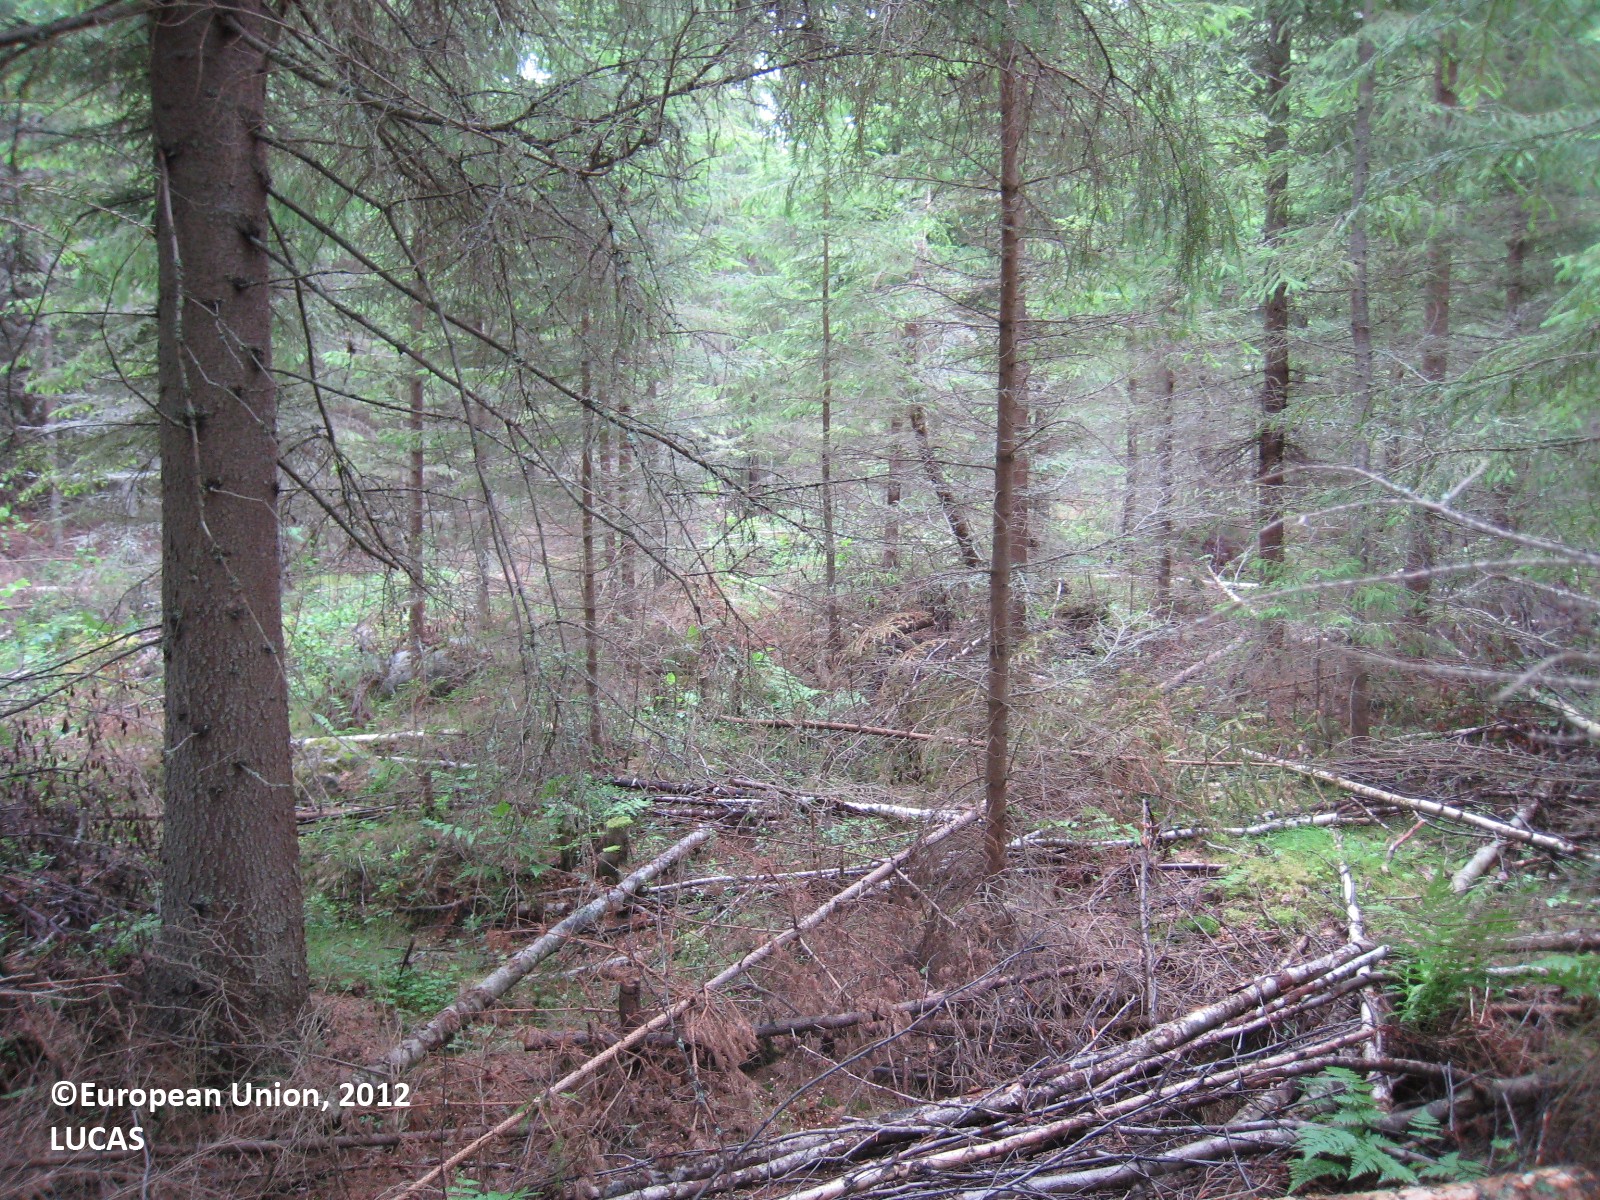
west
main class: Woodland
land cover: Spruce dominated coniferous woodland
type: boreal forest
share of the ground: > 75 %
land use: Forestry
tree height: > 5 m
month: July
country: FI
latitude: 61.7677
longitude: 27.2796
